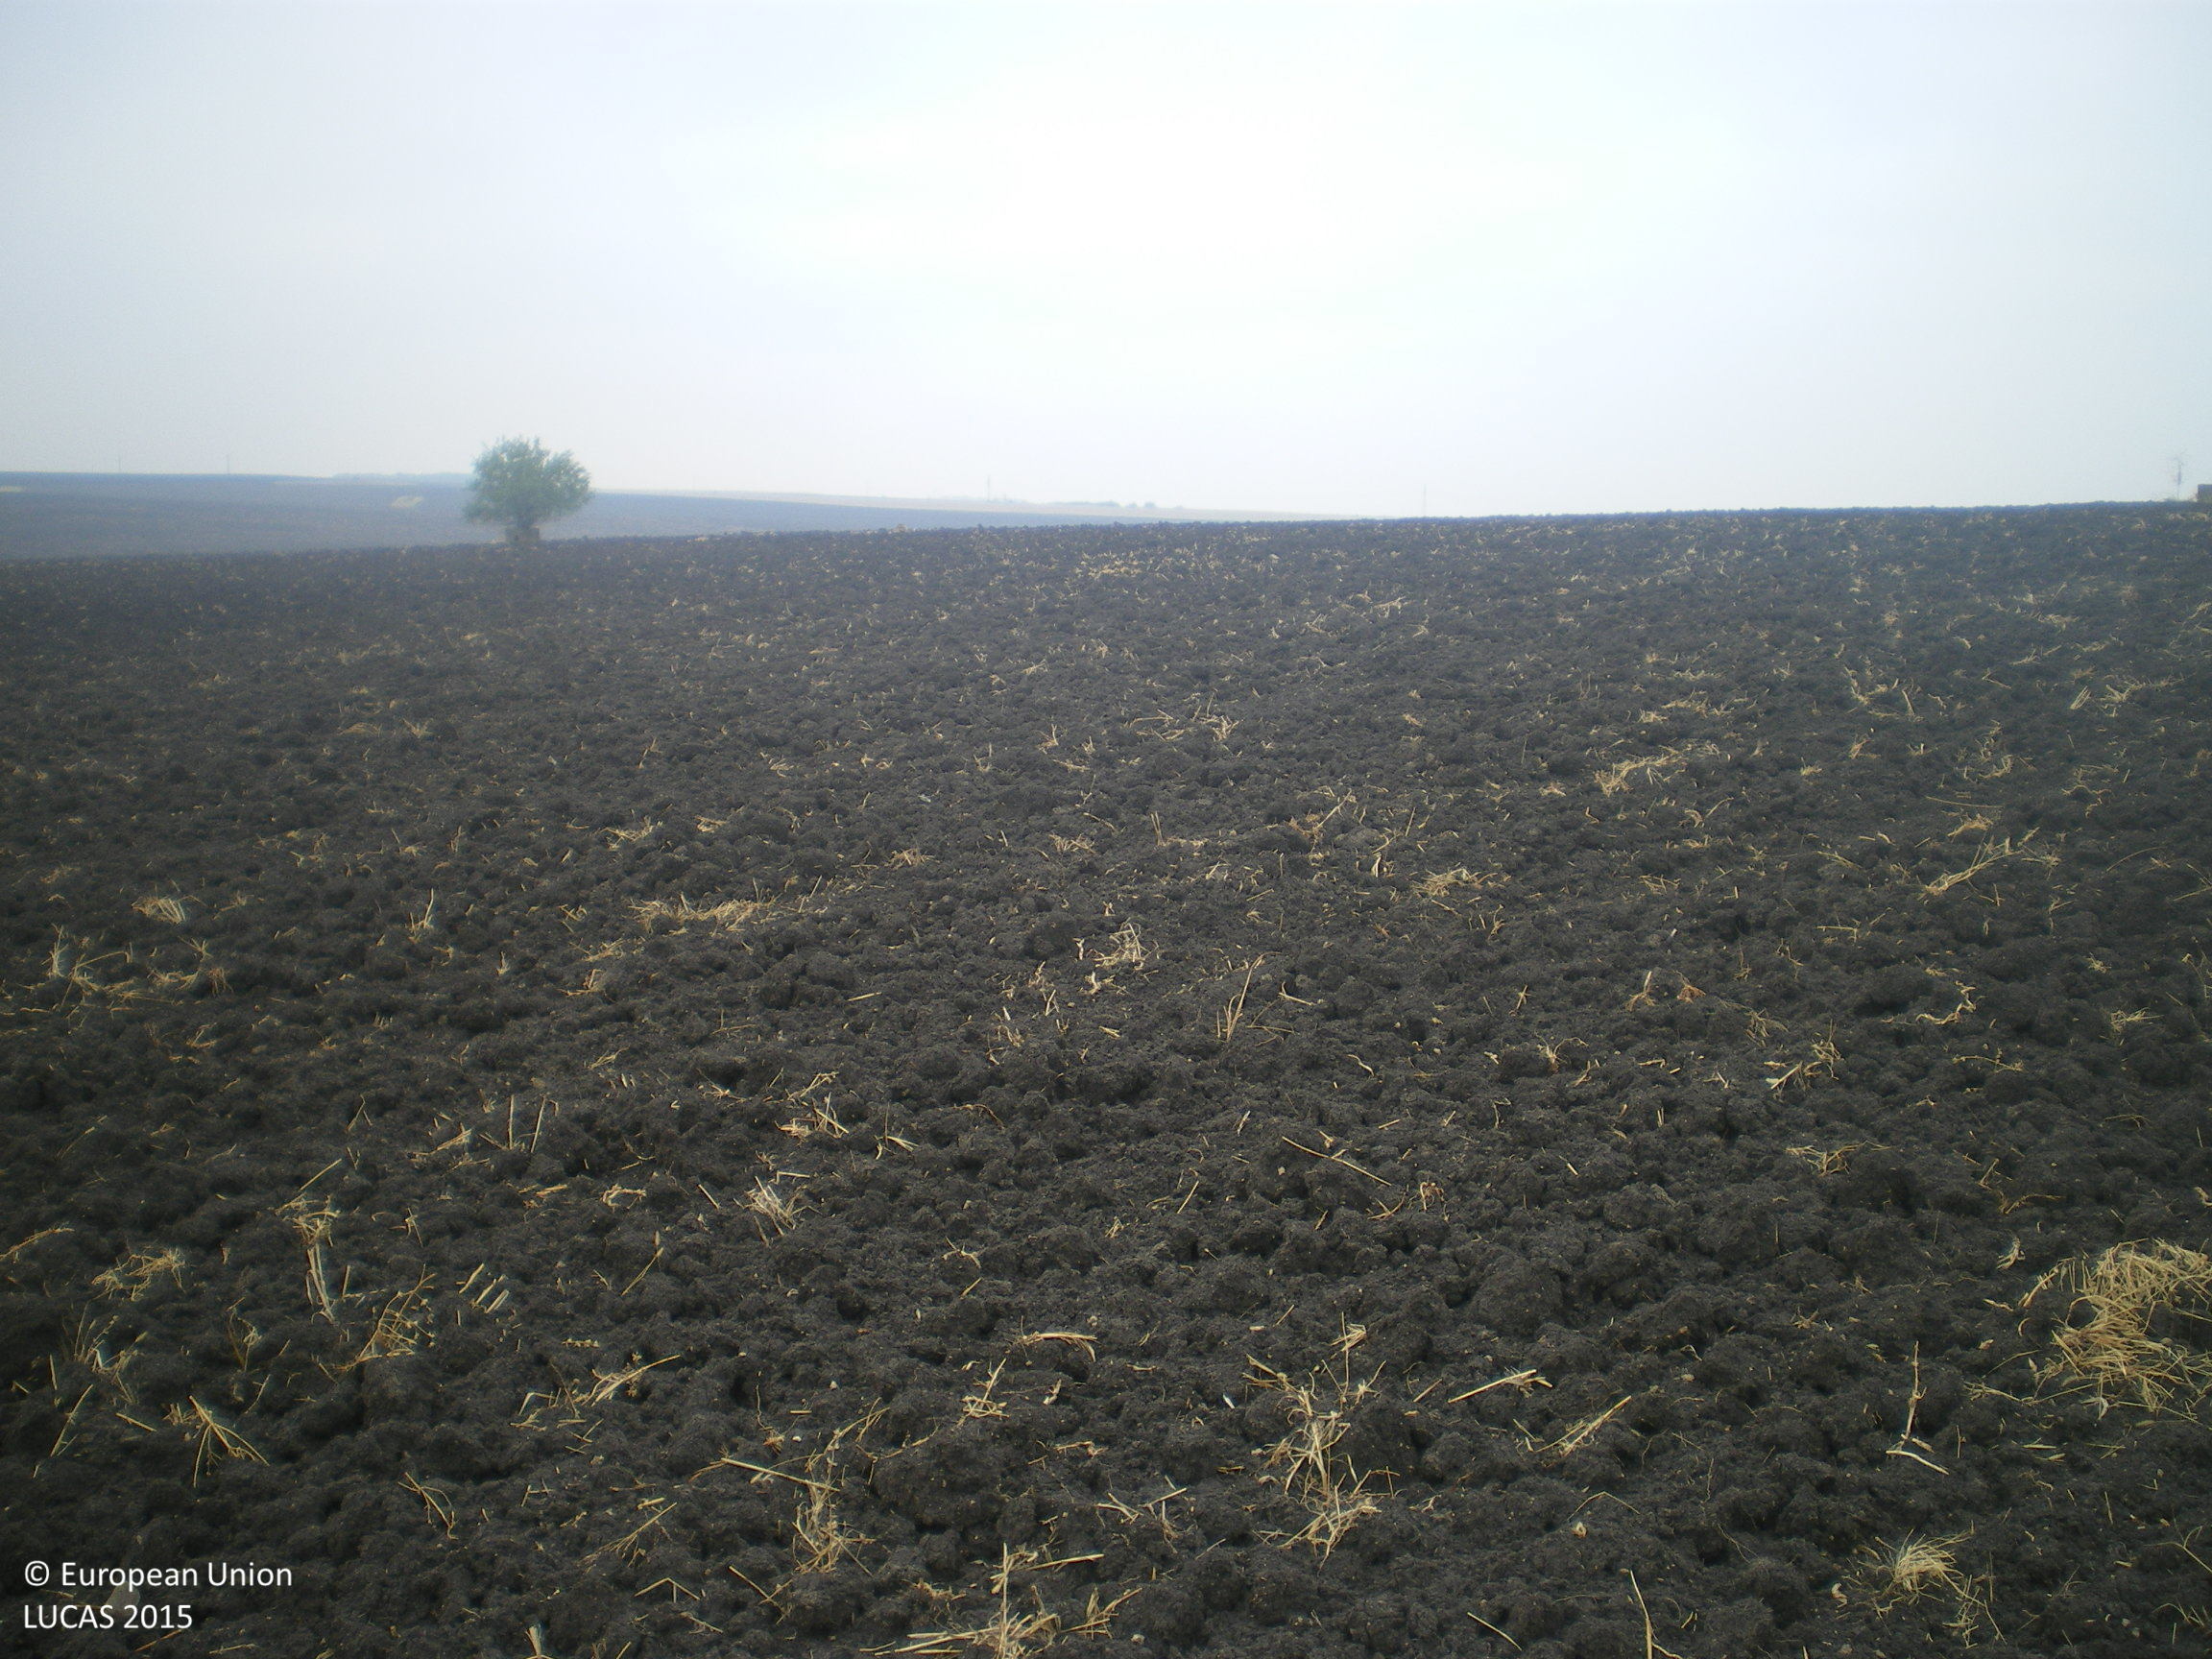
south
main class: Cropland
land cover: Common wheat
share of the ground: < 10 %
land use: Agriculture (excluding fallow land and kitchen gardens)
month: August
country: BG
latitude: 42.2808
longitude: 25.9502
